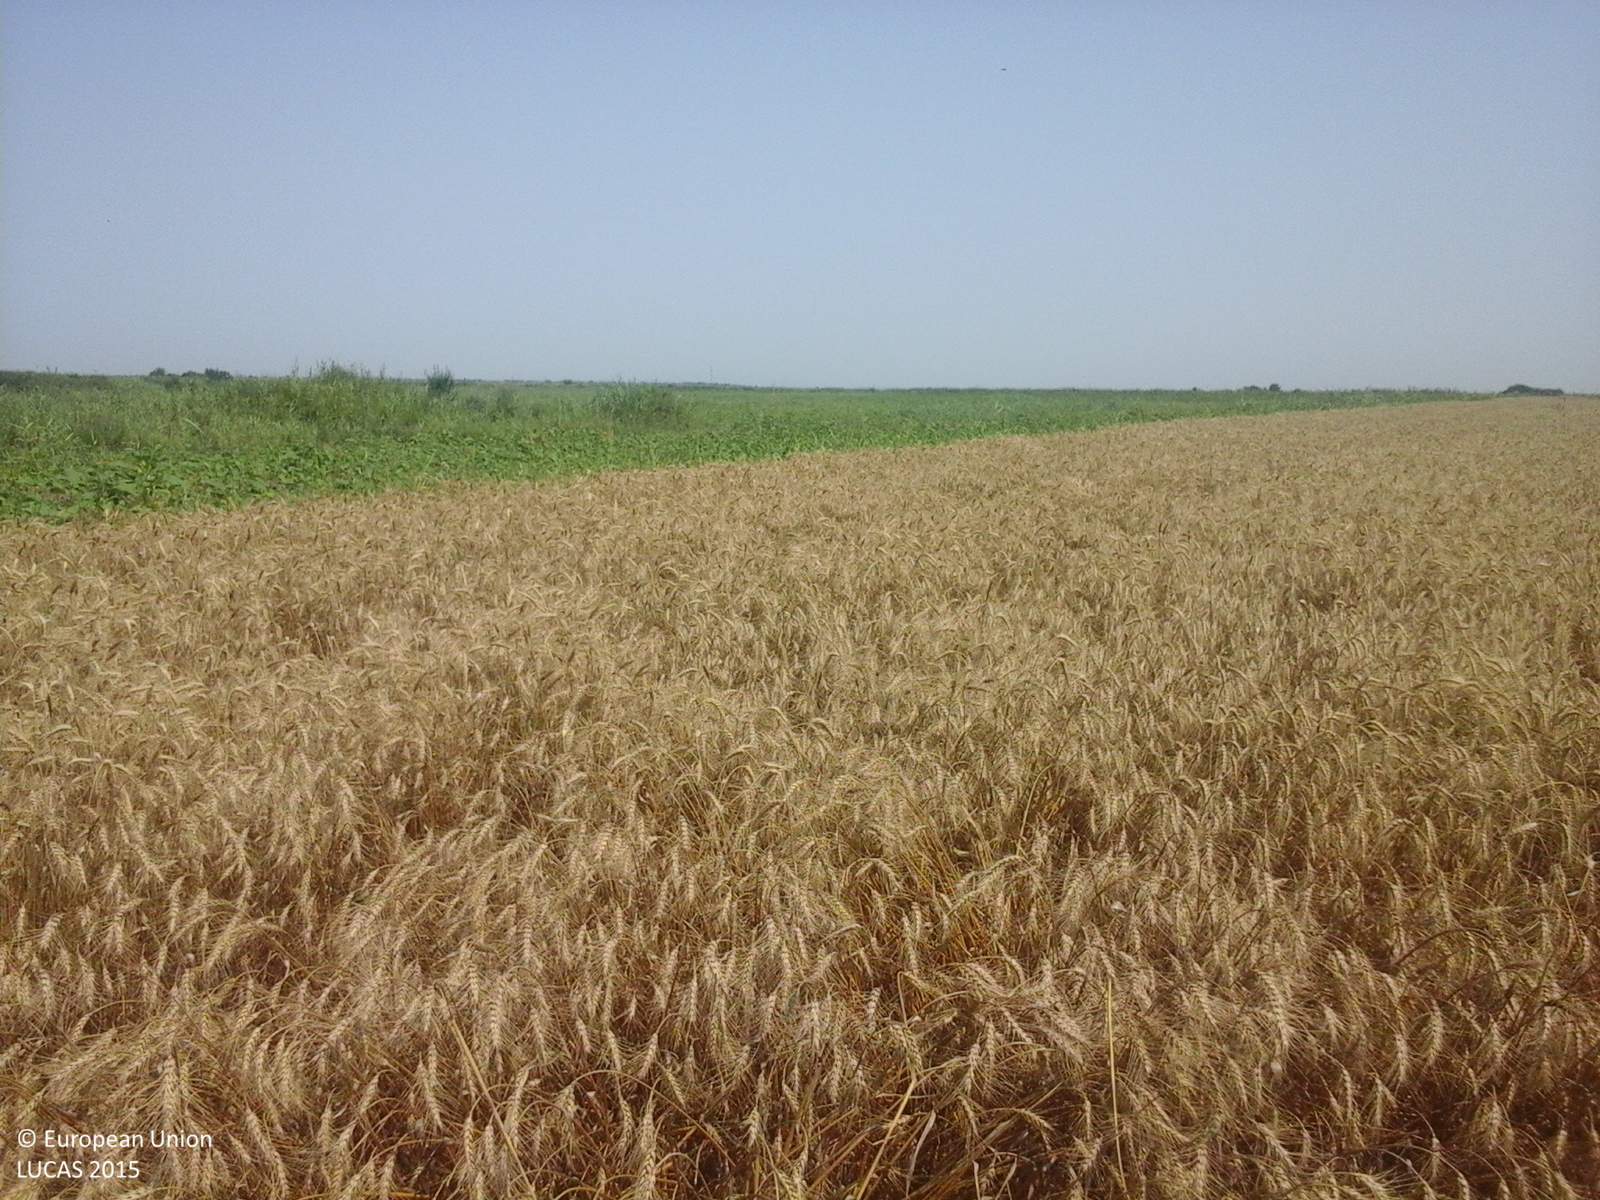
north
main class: Cropland
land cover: Durum wheat
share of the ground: > 75 %
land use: Agriculture (excluding fallow land and kitchen gardens)
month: July
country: RO
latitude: 44.7207
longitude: 26.5438
